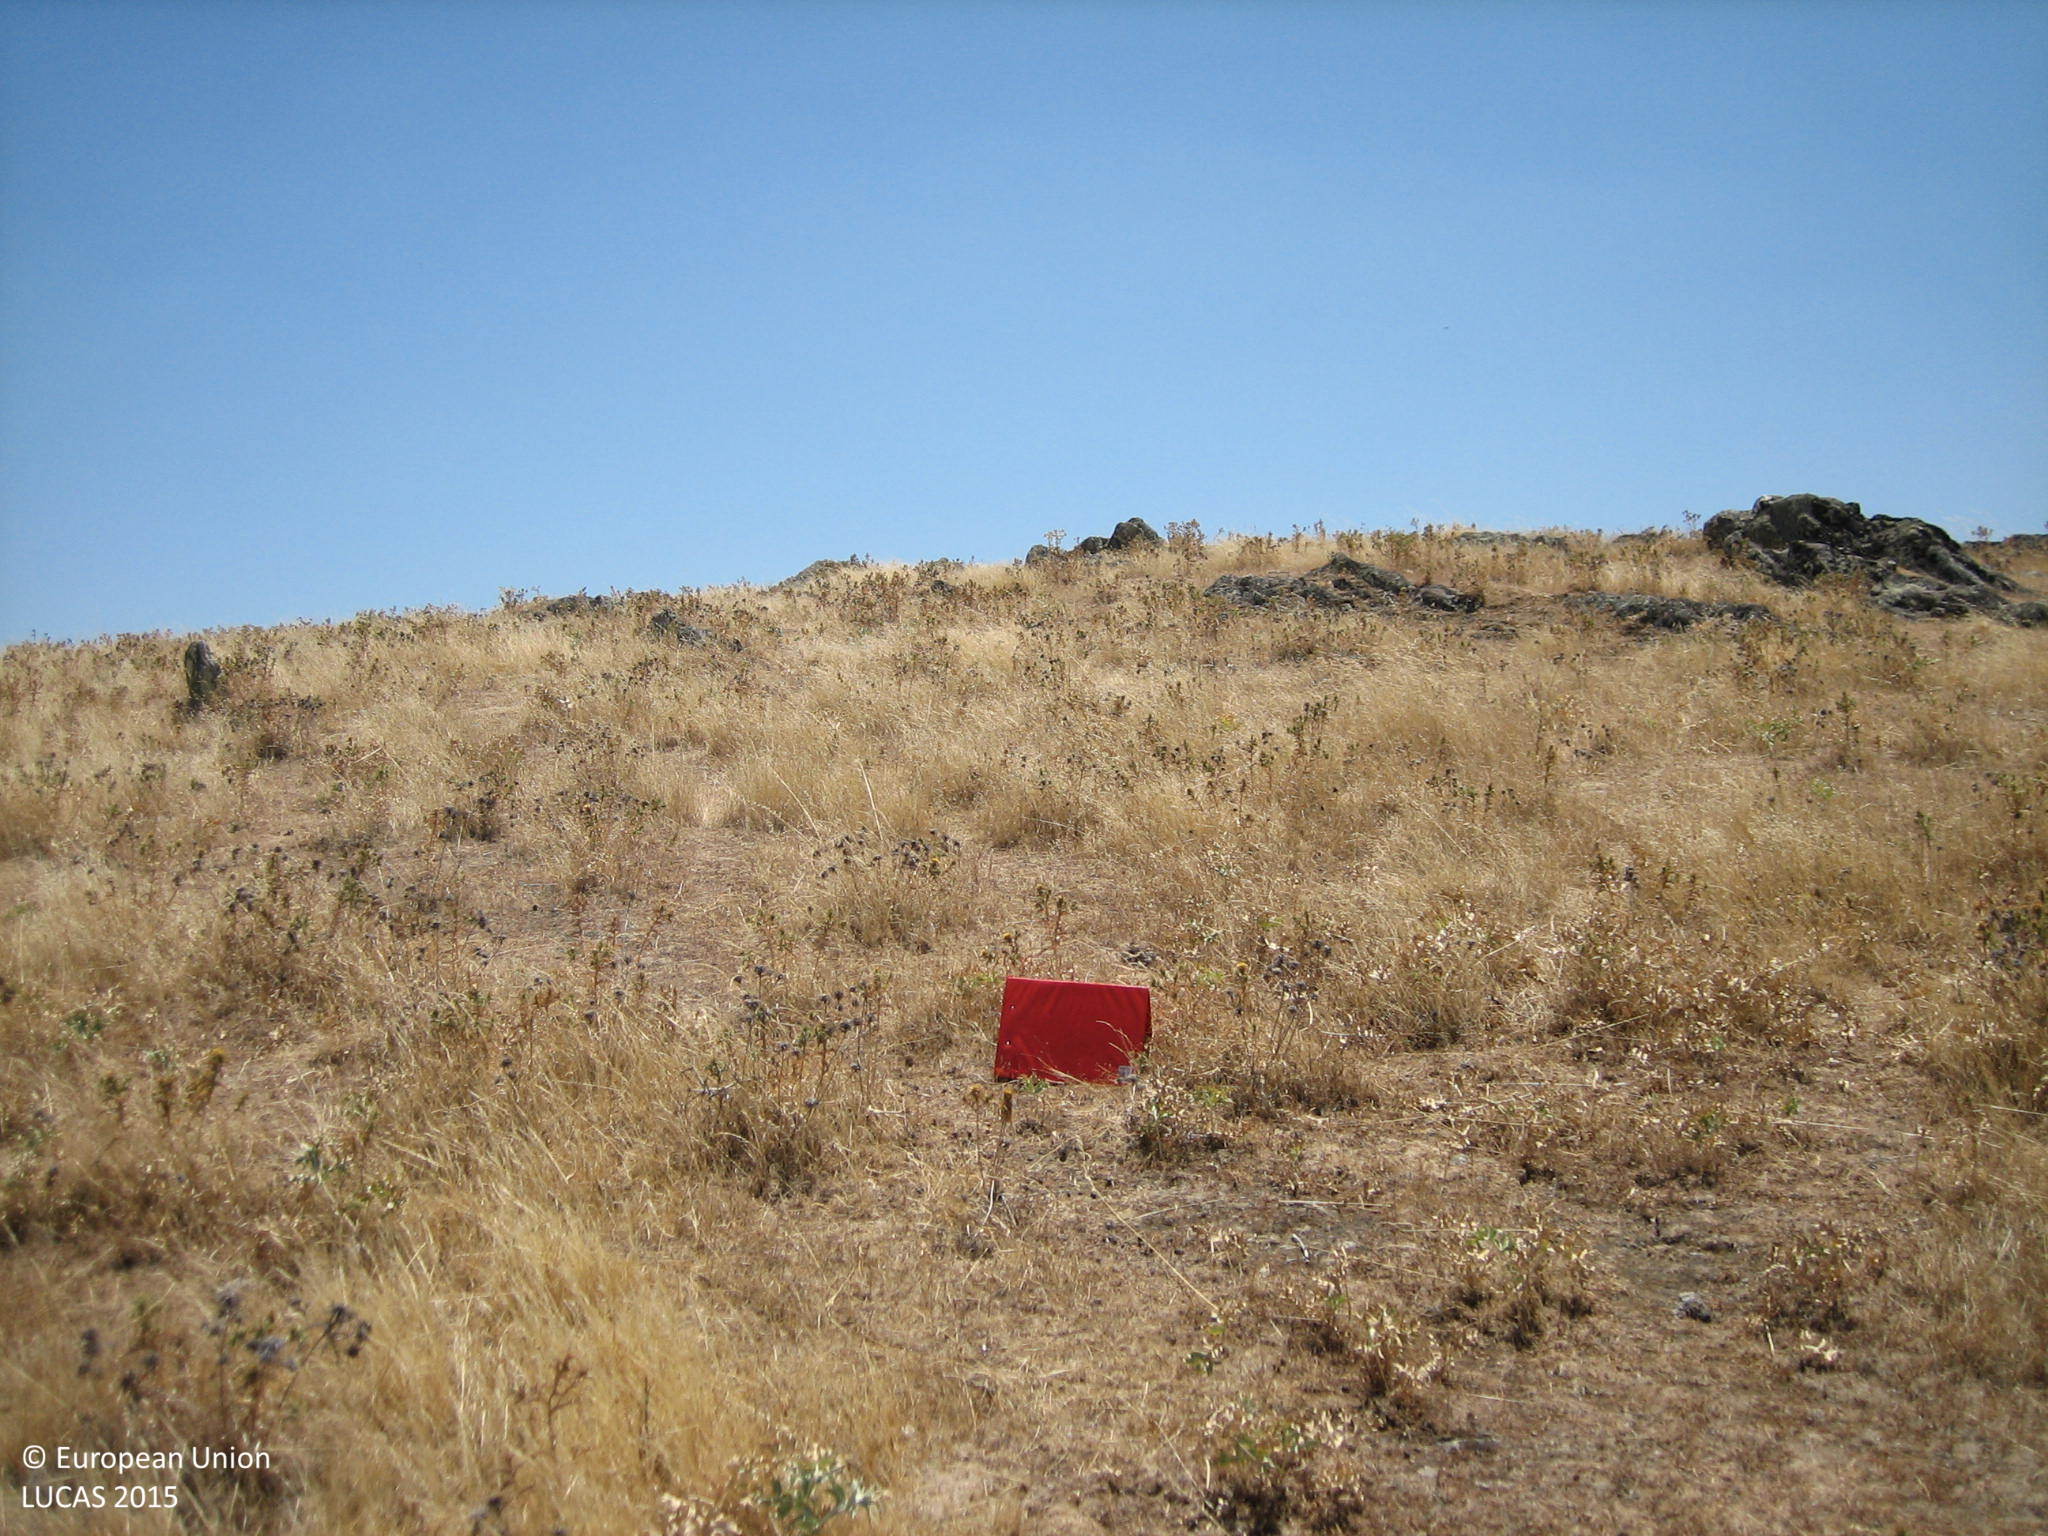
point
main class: Grassland
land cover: Grassland without tree/shrub cover
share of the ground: > 75 %
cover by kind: herbaceous plants 100 %
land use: Agriculture (excluding fallow land and kitchen gardens)
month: July
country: ES
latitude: 38.1989
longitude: -6.2698
